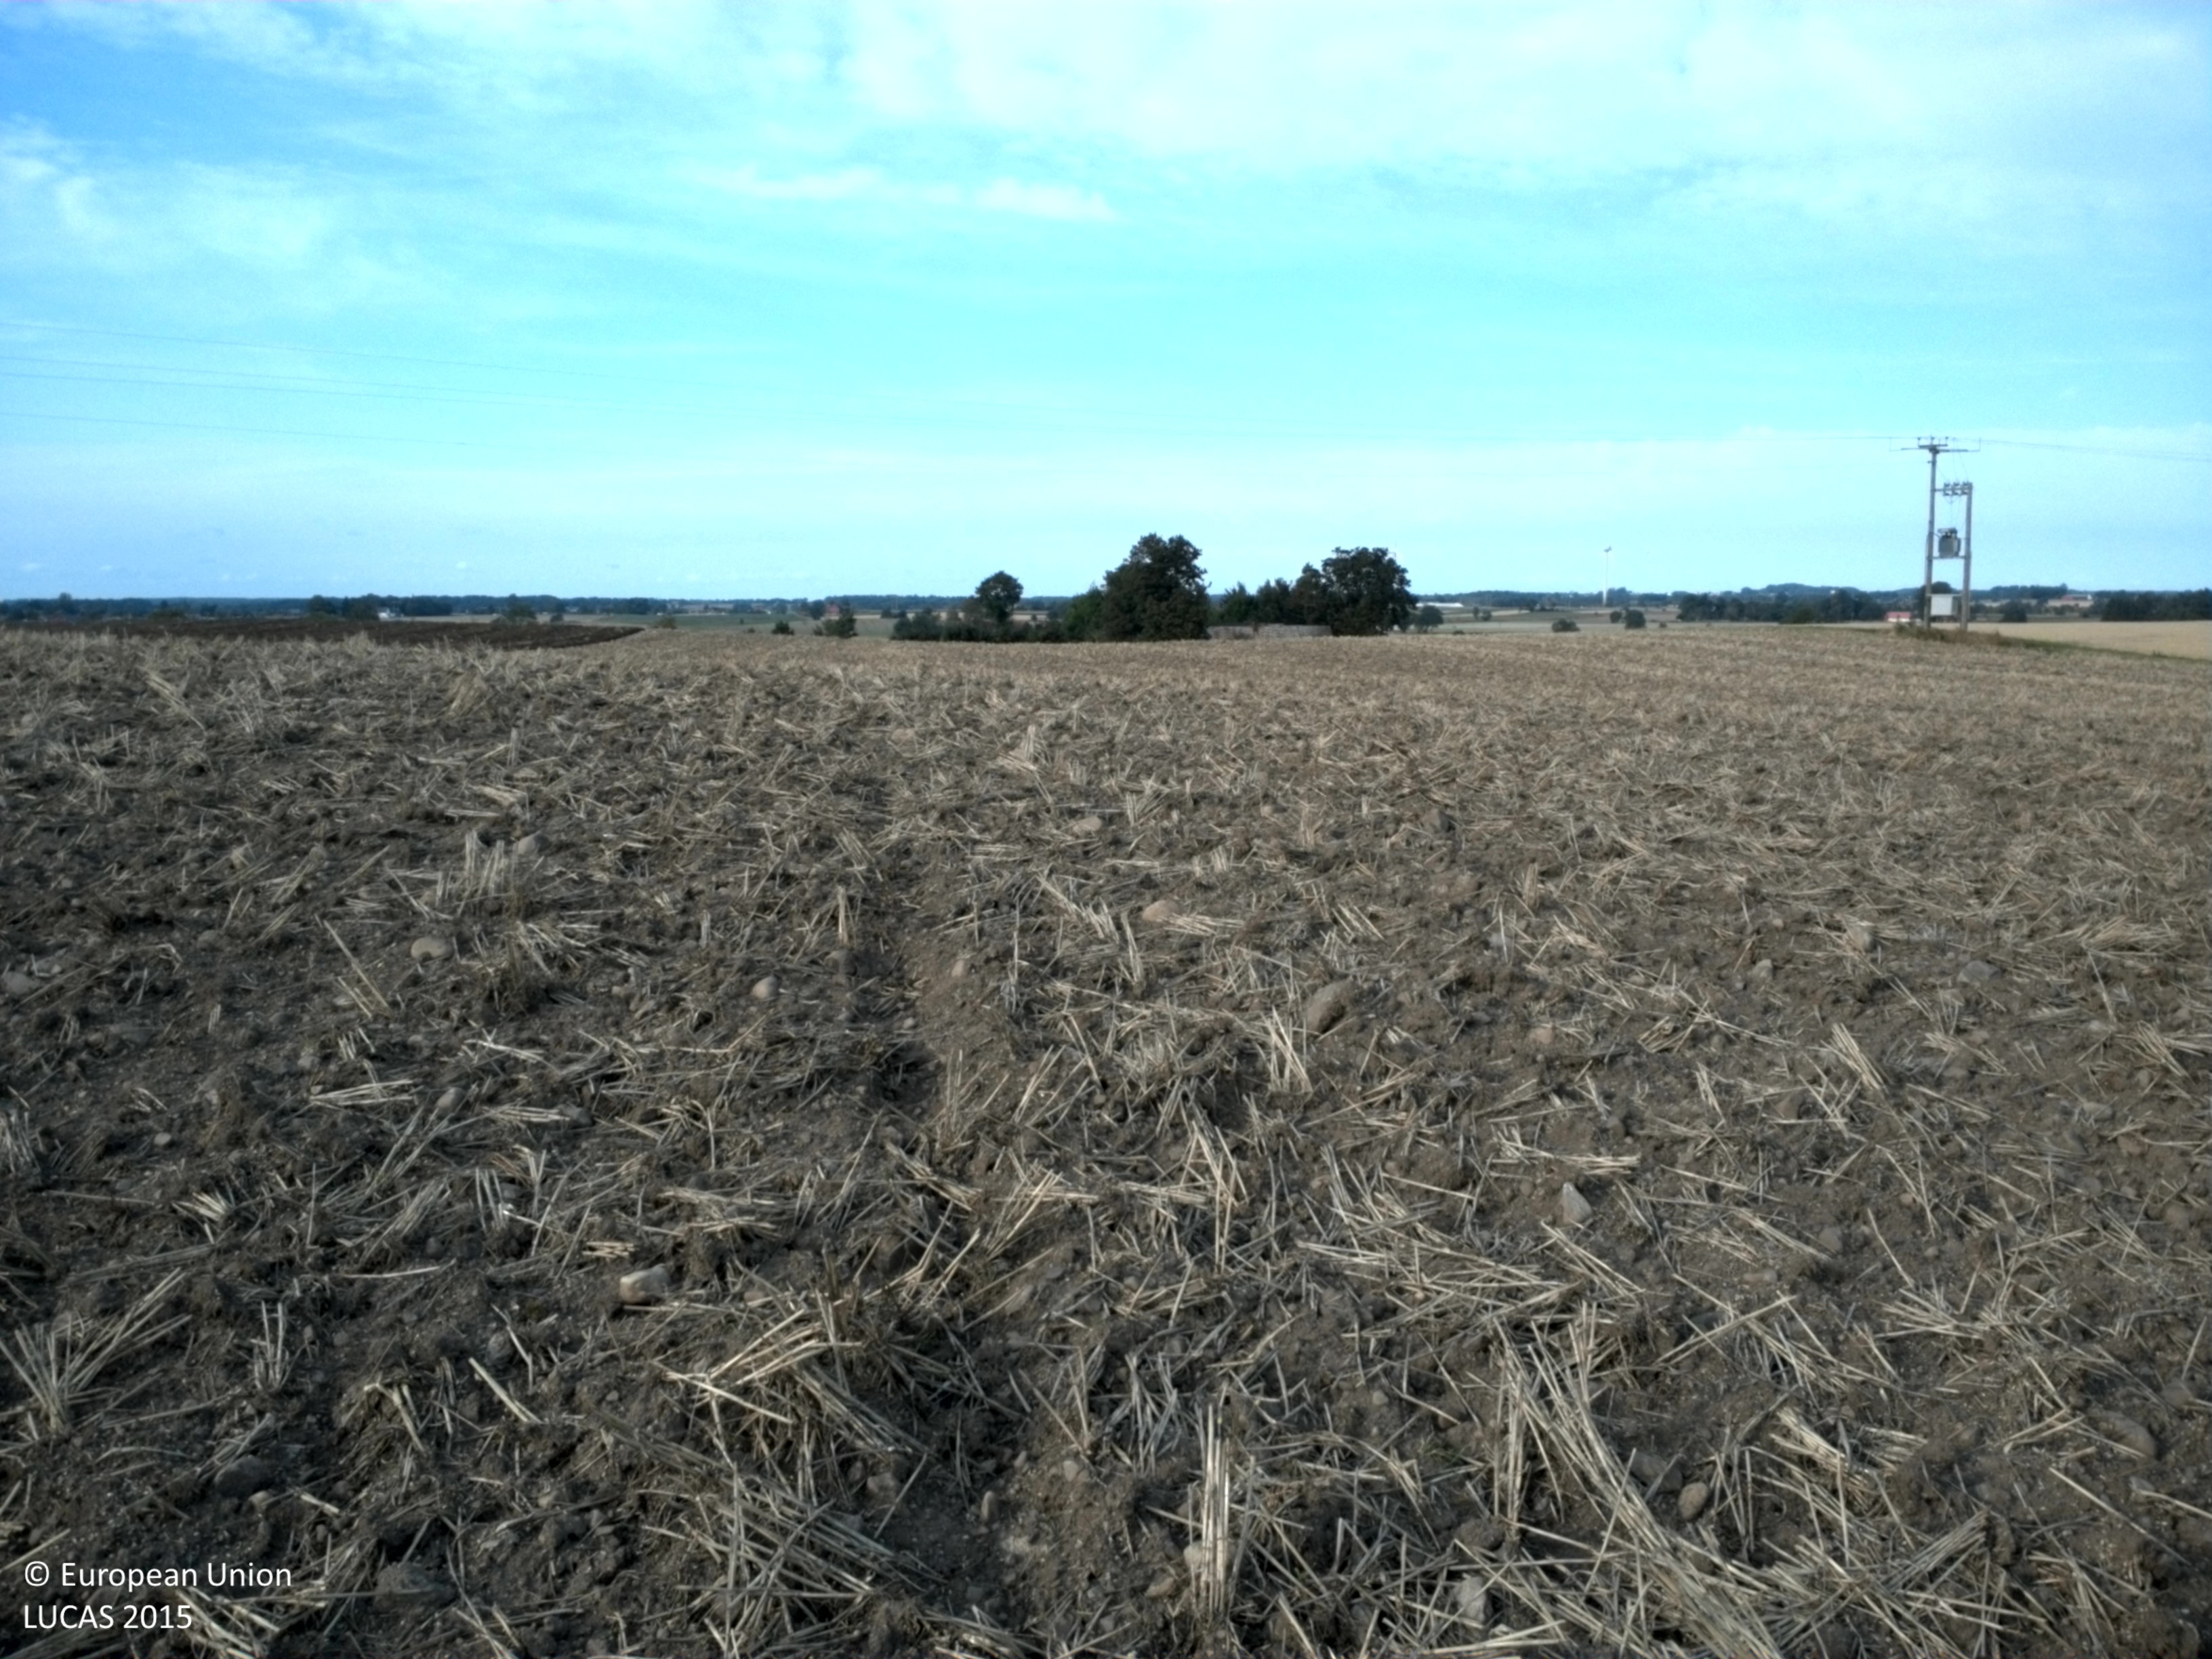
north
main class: Cropland
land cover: Common wheat
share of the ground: < 10 %
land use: Agriculture (excluding fallow land and kitchen gardens)
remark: Harvested field
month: September
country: SE
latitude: 55.5682
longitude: 13.9788
